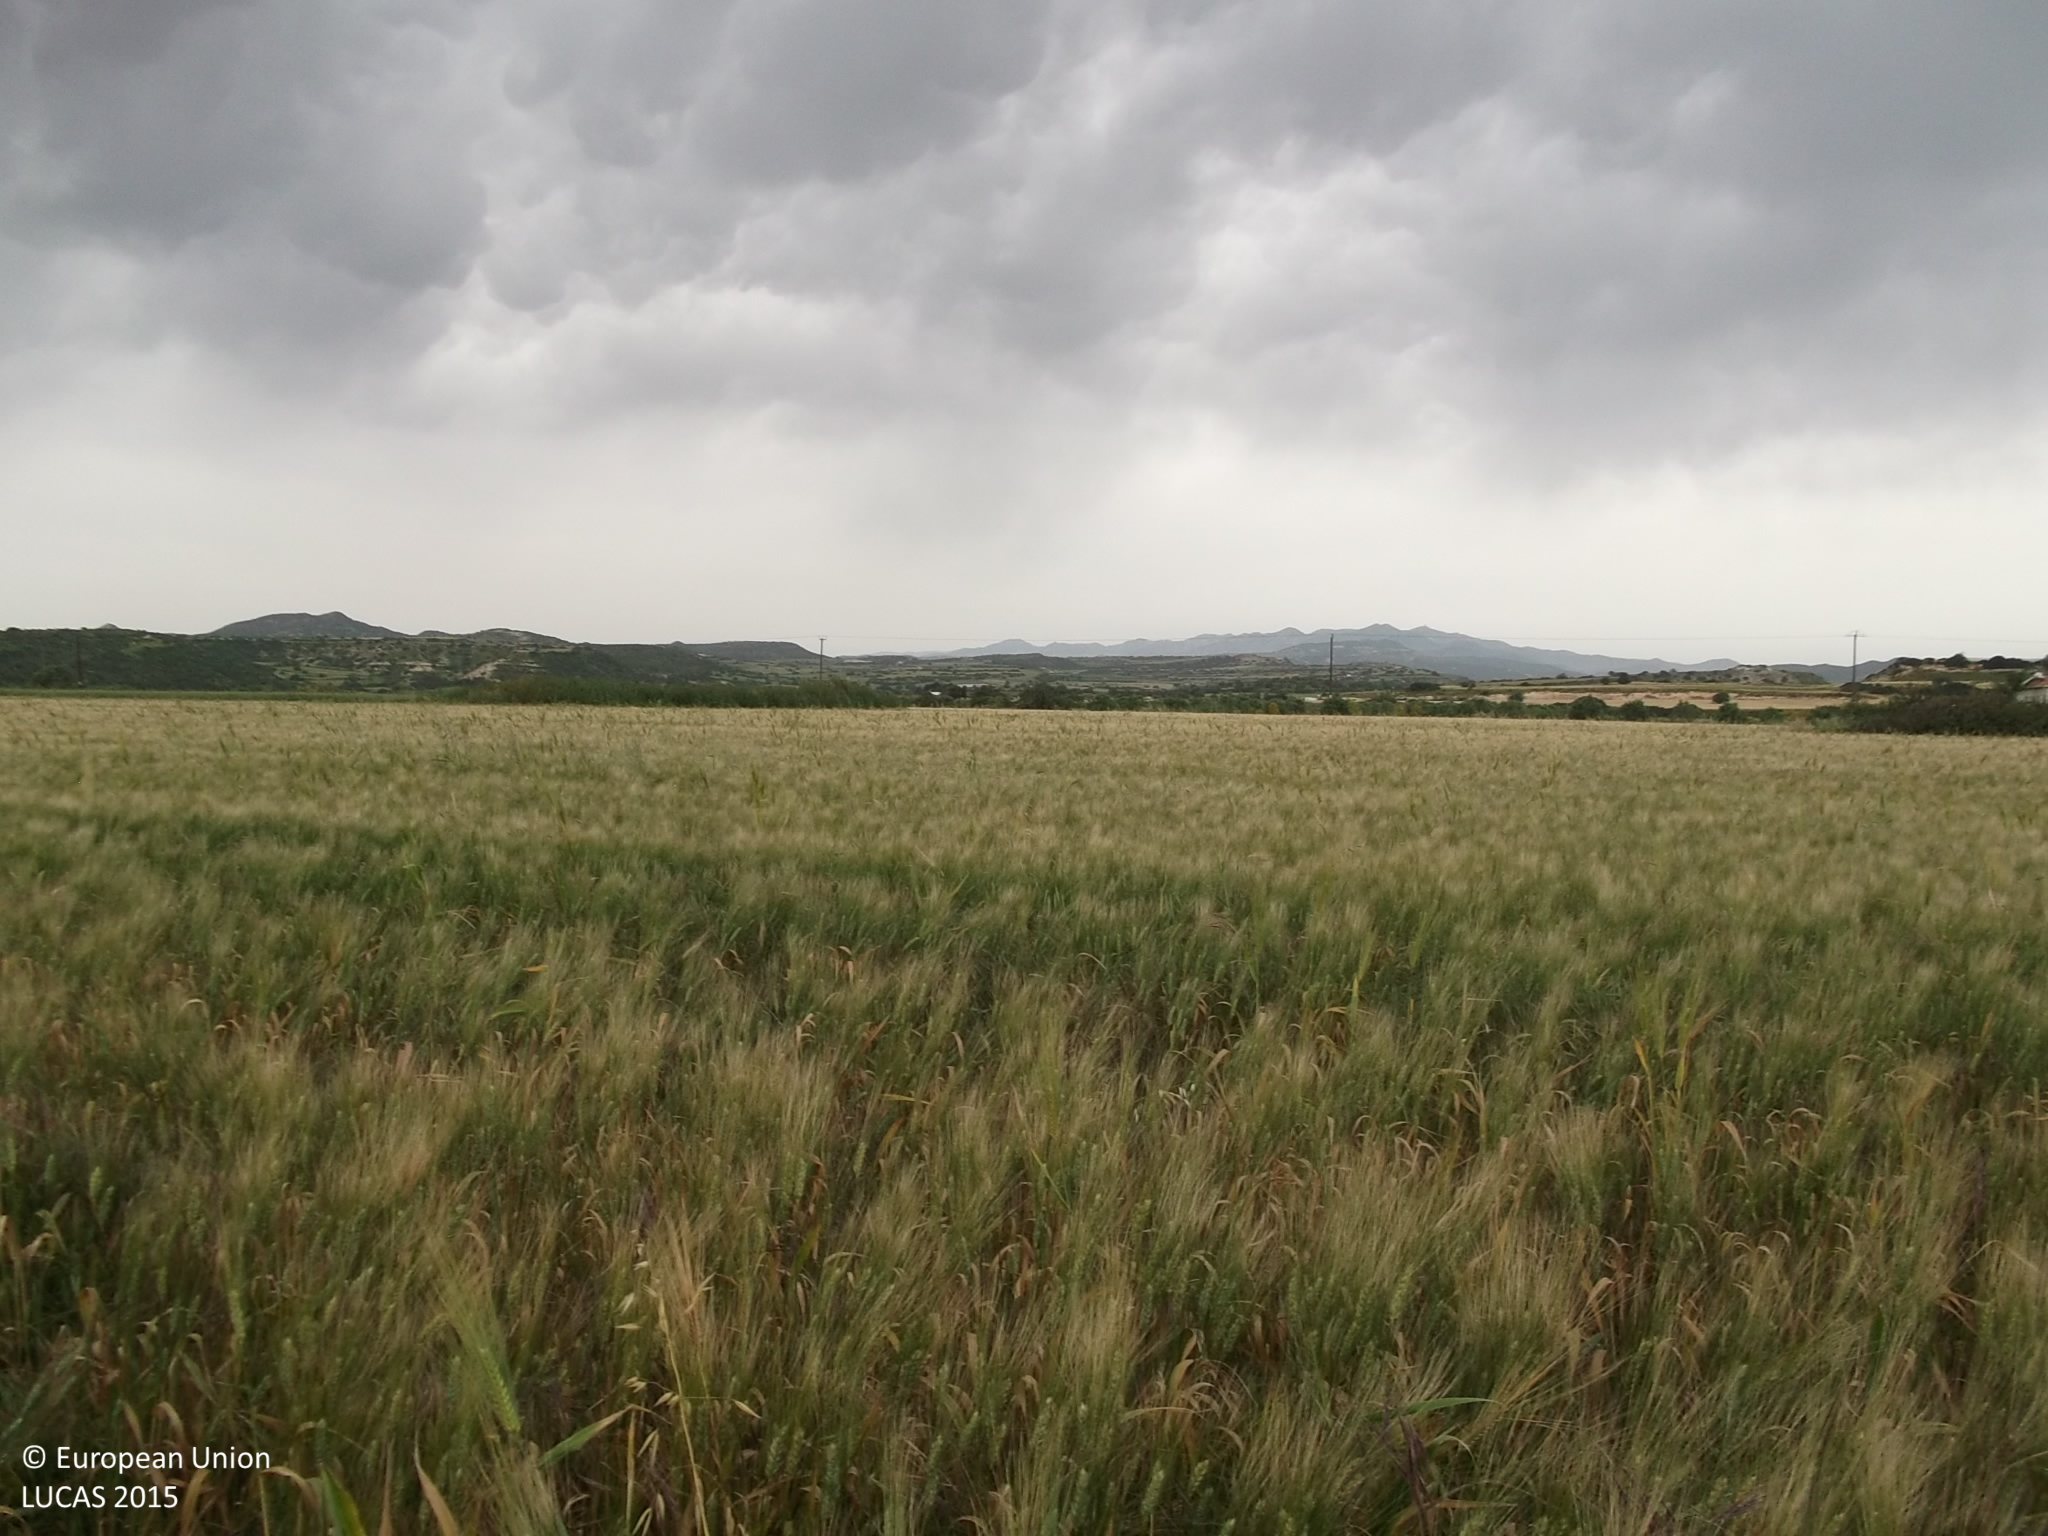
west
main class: Cropland
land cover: Mixed cereals for fodder
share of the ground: > 75 %
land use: Agriculture (excluding fallow land and kitchen gardens)
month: April
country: CY
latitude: 34.7842
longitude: 33.4733
